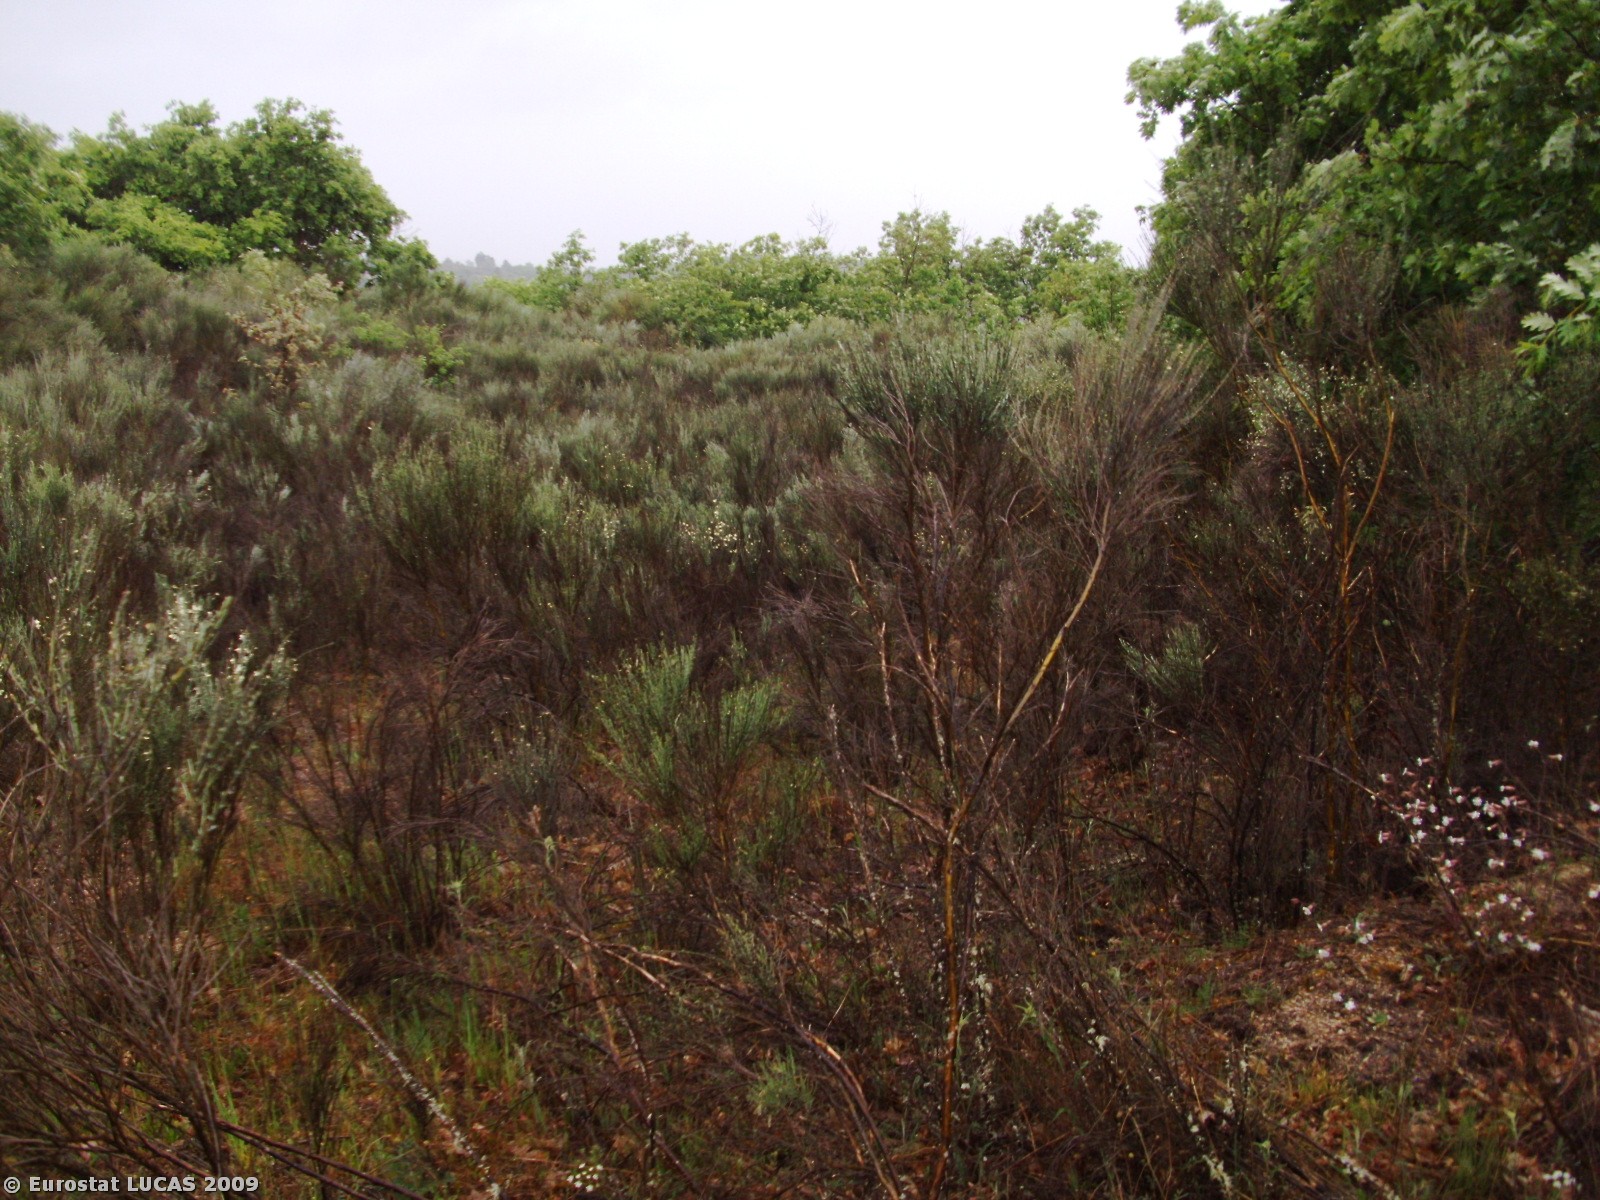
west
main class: Shrubland
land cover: Shrubland with sparse tree cover
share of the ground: > 75 %
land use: Unused
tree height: > 5 m
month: May
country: PT
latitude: 40.6219
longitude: -7.0658
